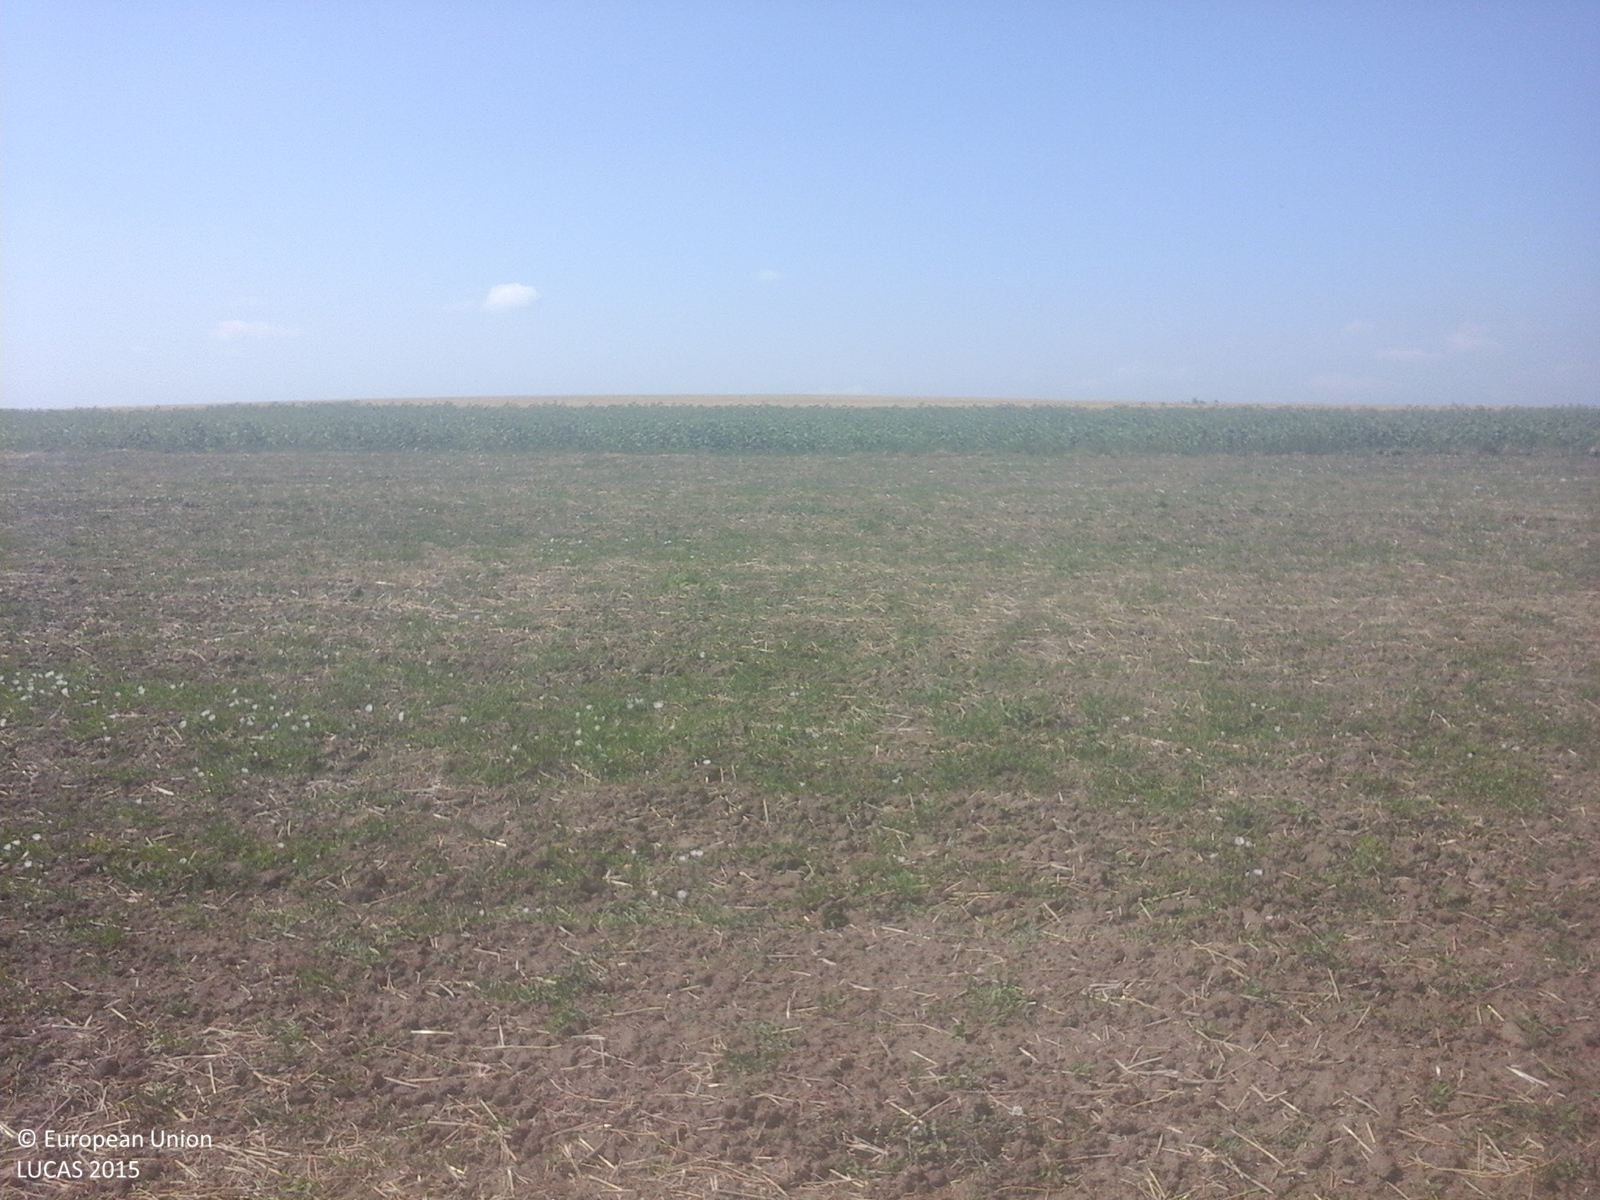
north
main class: Grassland
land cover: Spontaneously vegetated surfaces
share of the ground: < 10 %
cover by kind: herbaceous plants 100 %
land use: Fallow land
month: June
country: RO
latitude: 46.8608
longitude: 27.5206
